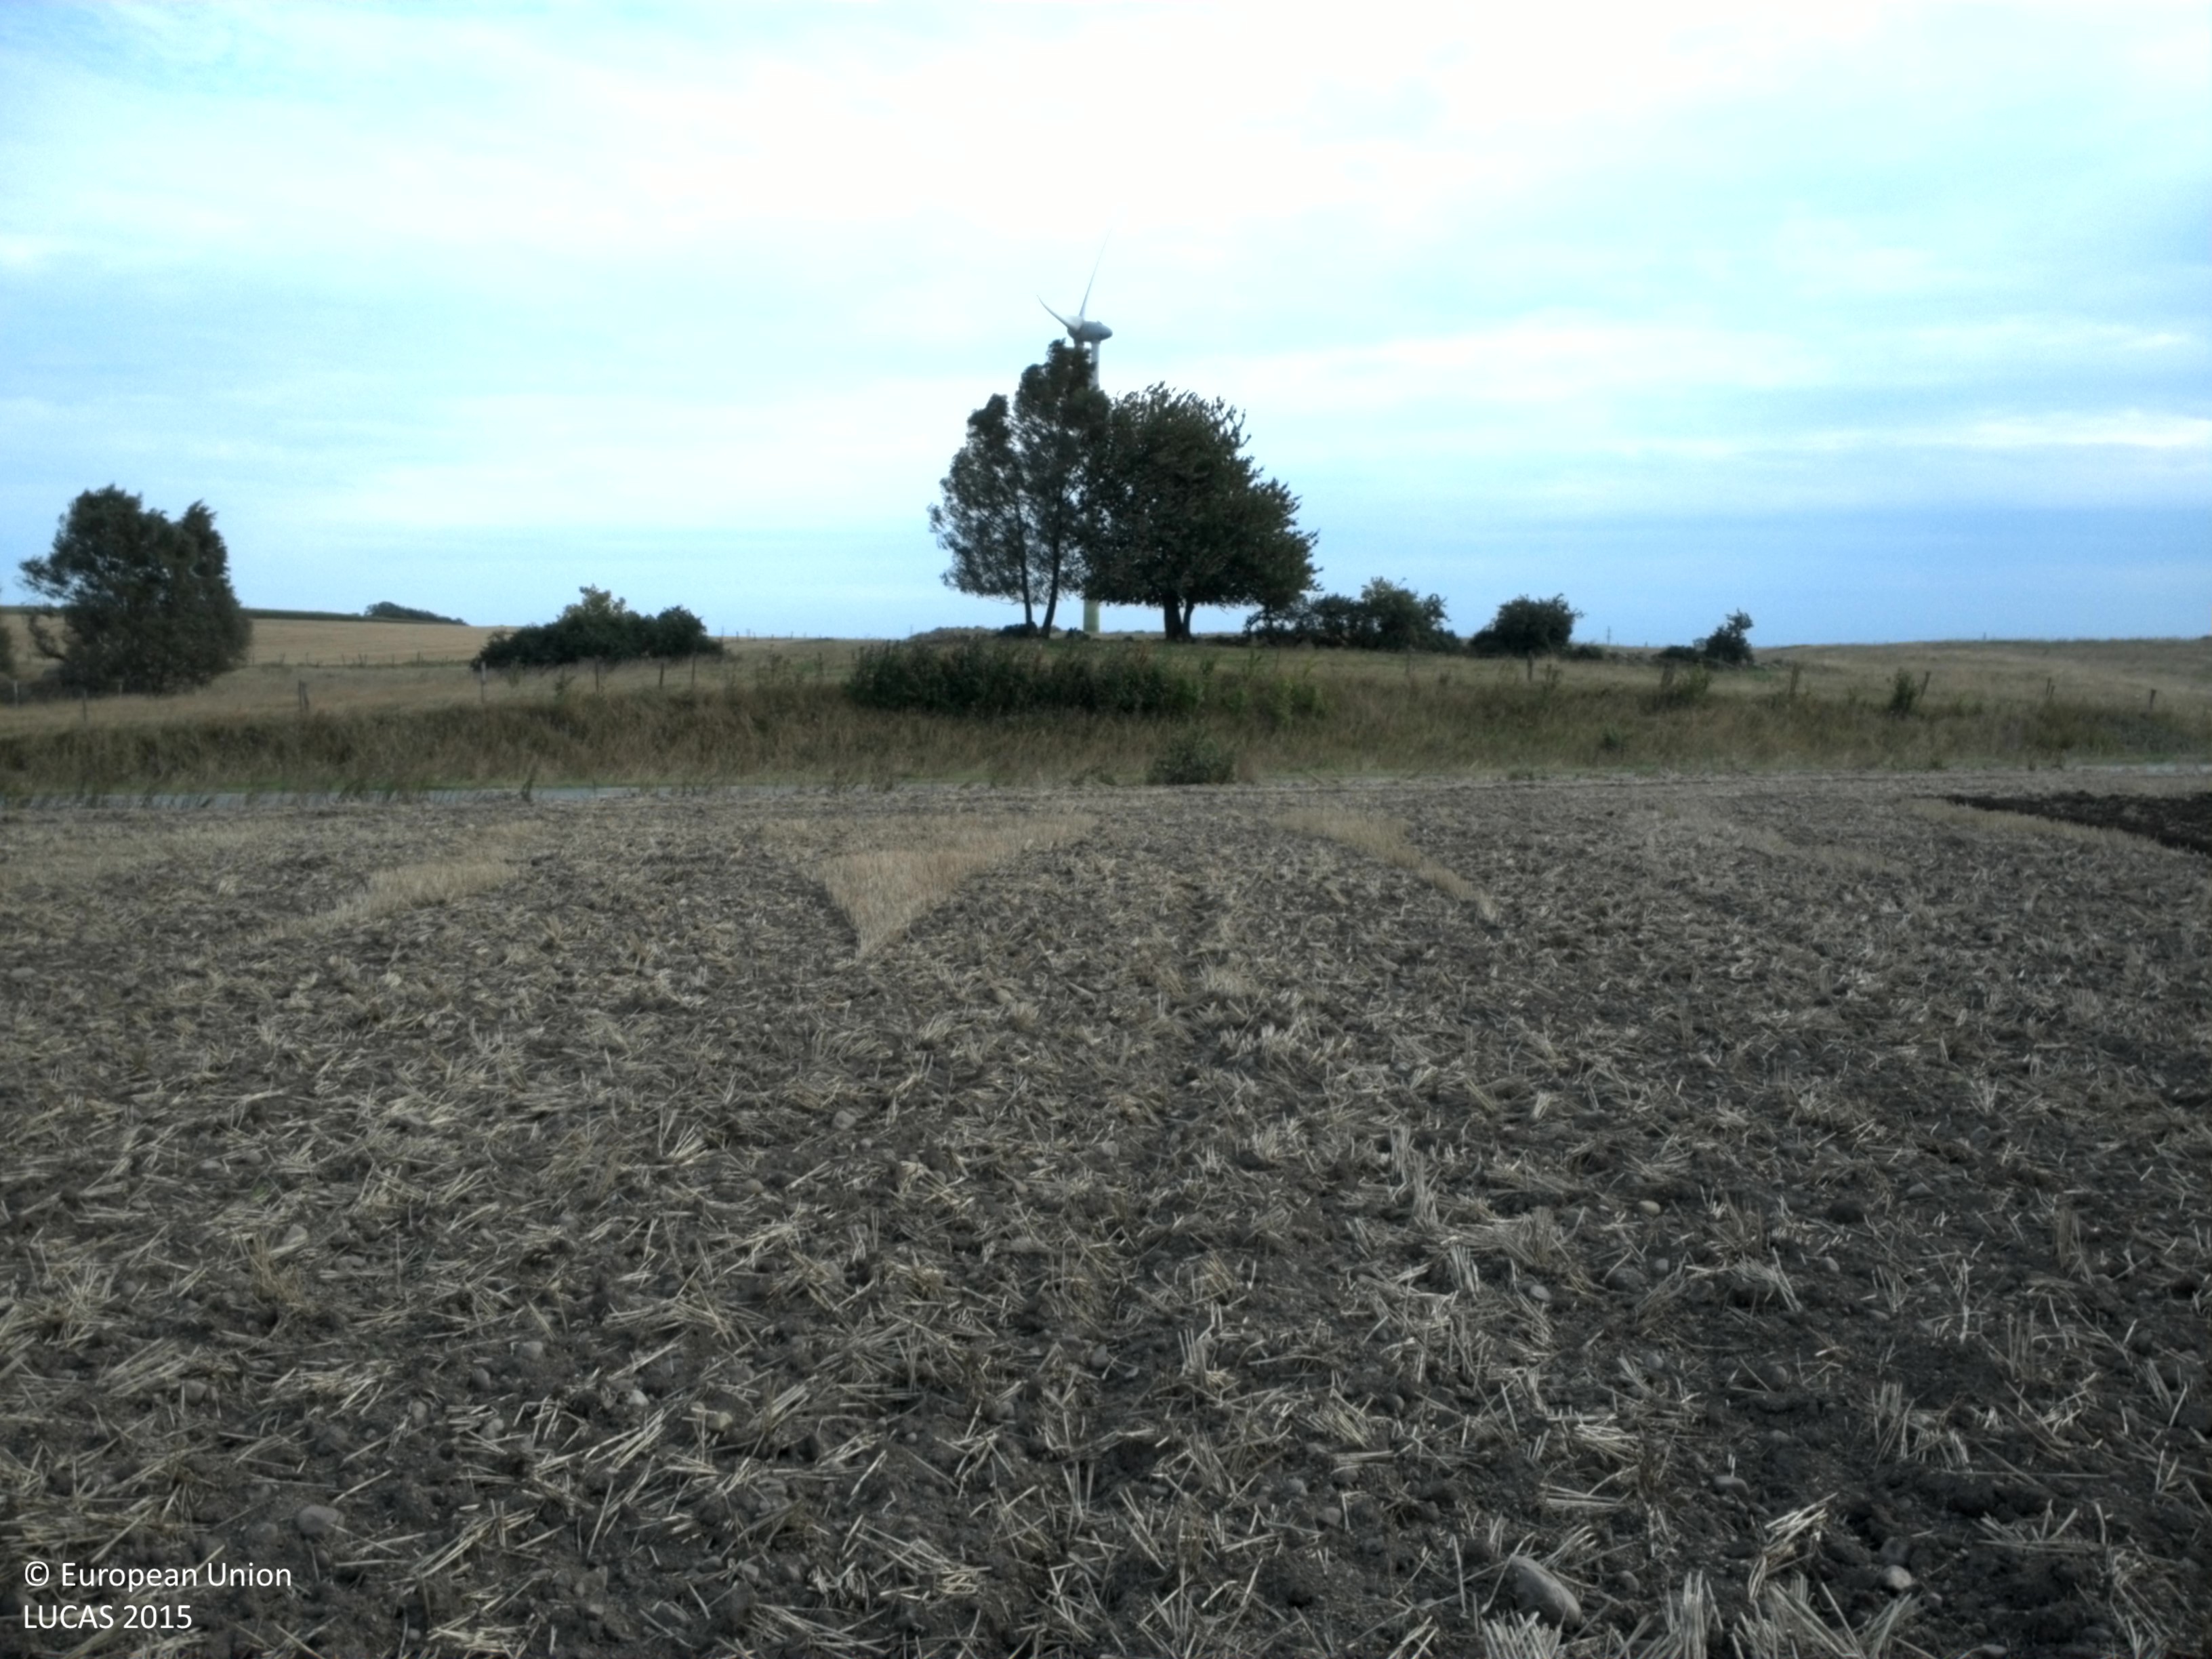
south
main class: Cropland
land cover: Common wheat
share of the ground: < 10 %
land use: Agriculture (excluding fallow land and kitchen gardens)
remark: Harvested field
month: September
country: SE
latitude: 55.5682
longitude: 13.9788
